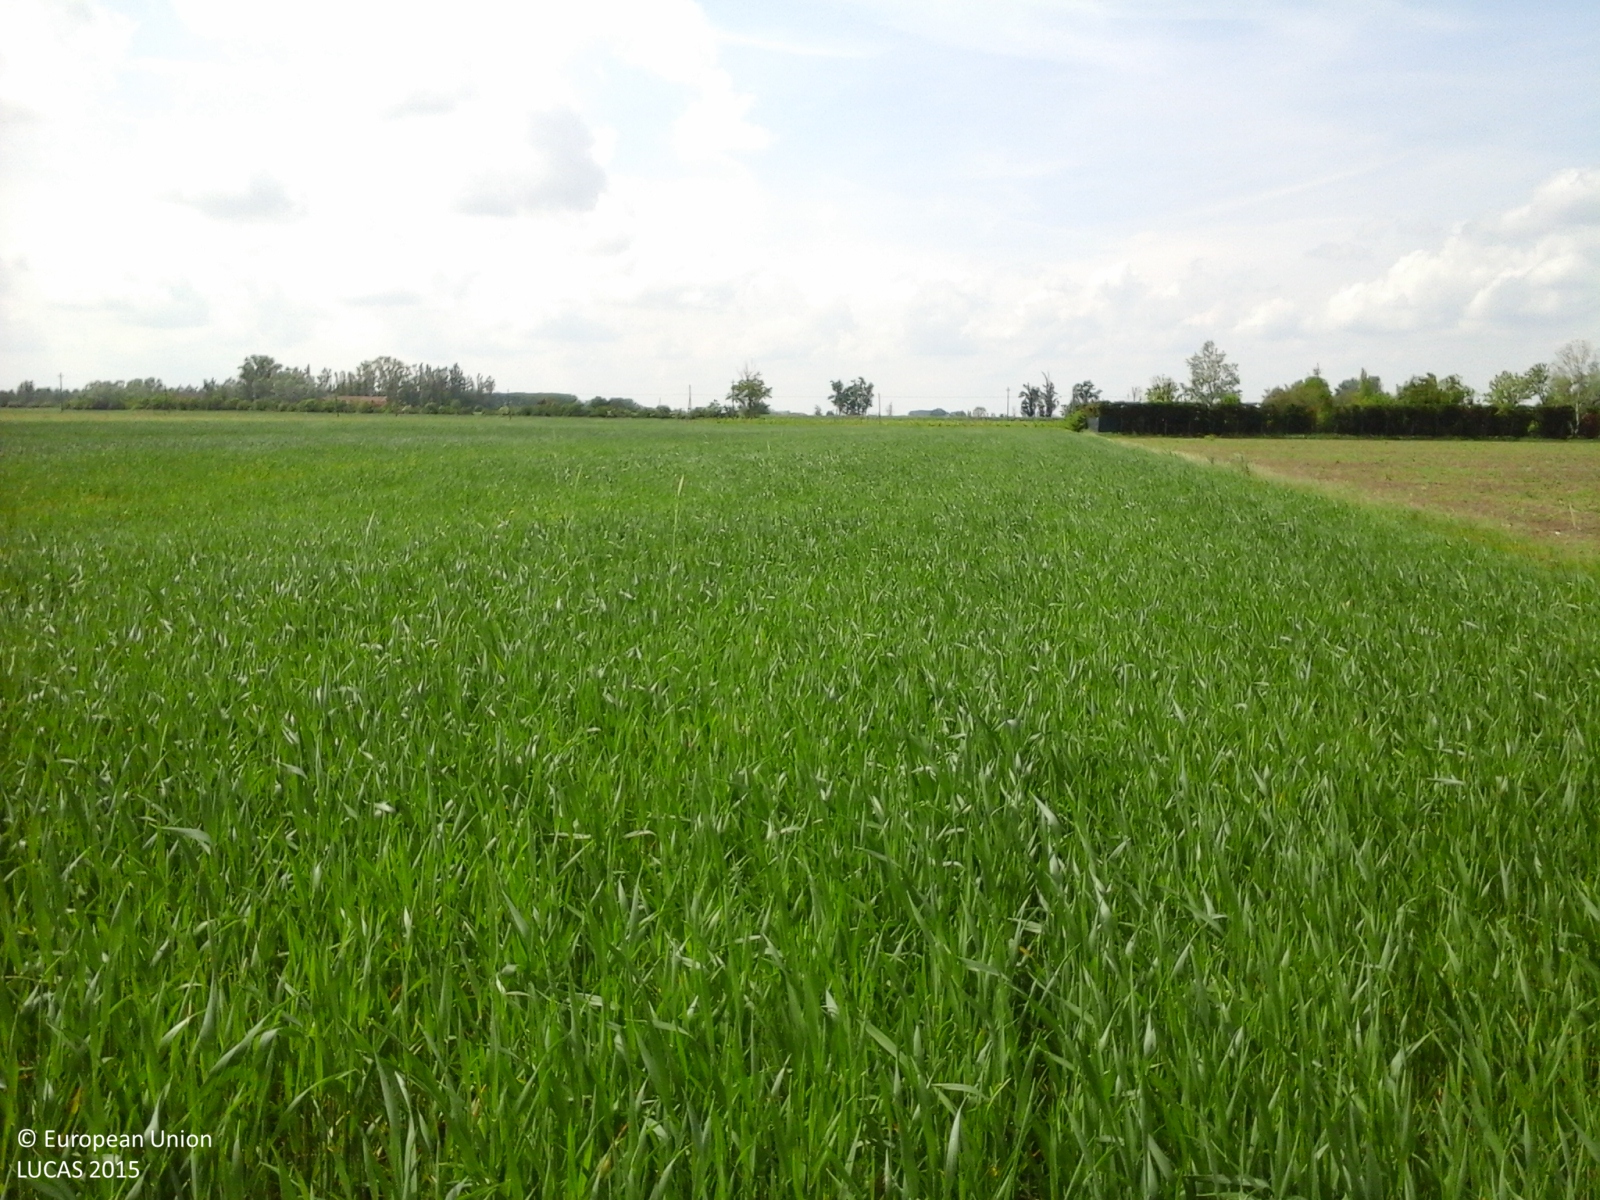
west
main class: Cropland
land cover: Common wheat
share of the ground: > 75 %
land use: Agriculture (excluding fallow land and kitchen gardens)
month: April
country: IT
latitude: 44.8340
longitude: 10.8458
